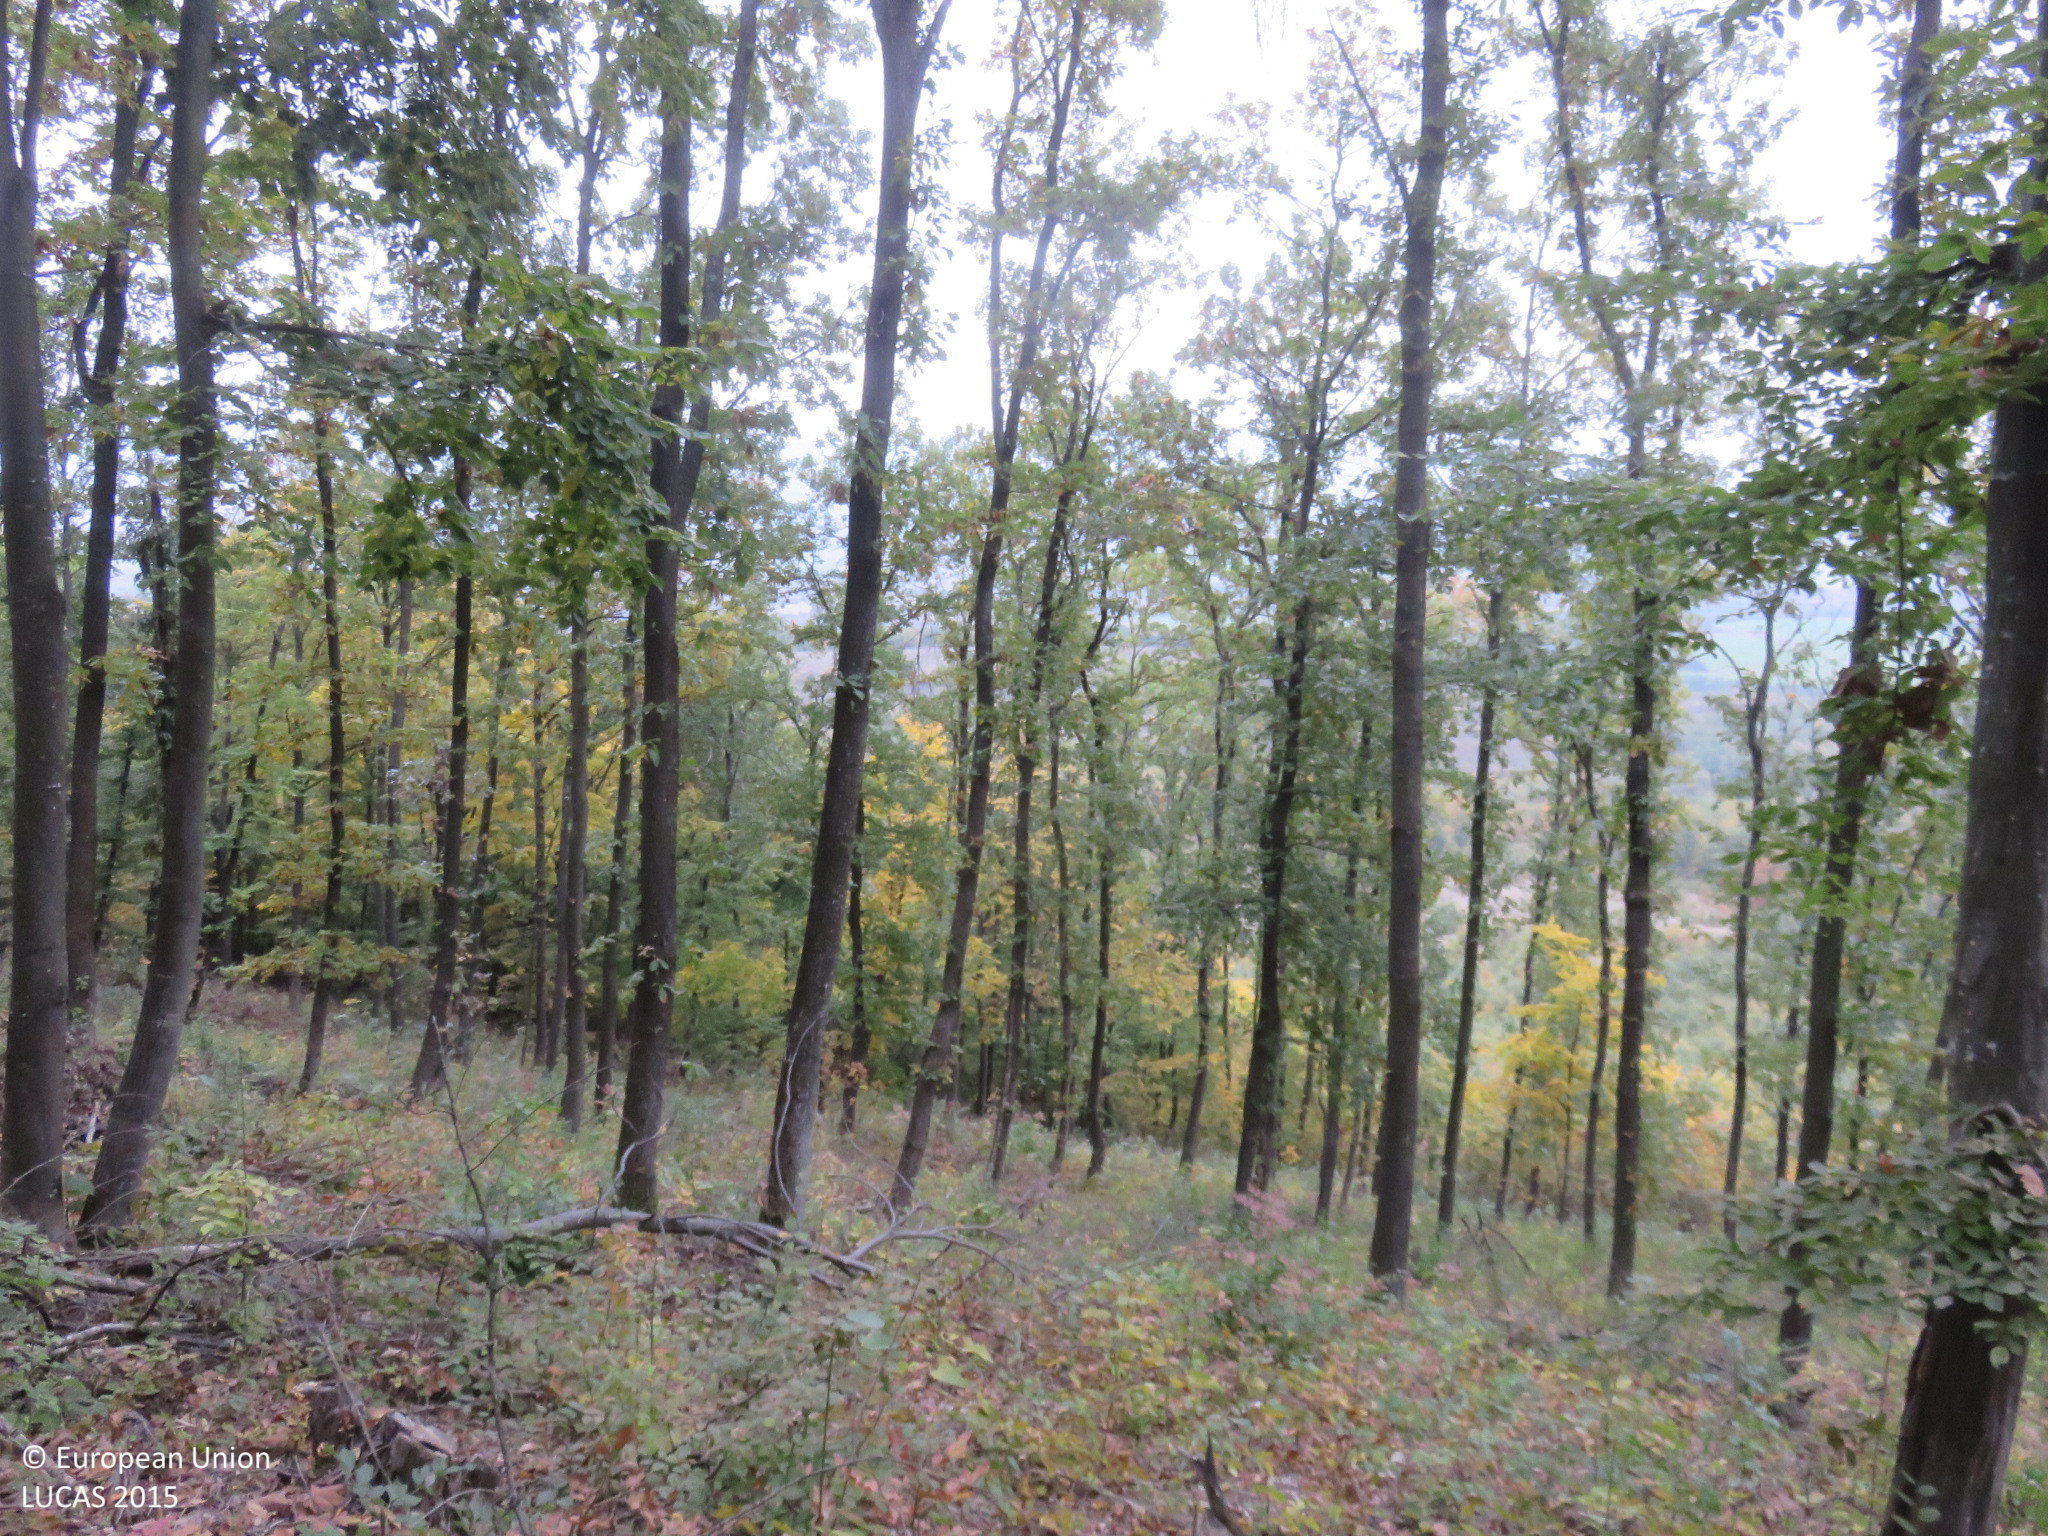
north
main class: Woodland
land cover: Broadleaved woodland
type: mesophytic deciduous forest
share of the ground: > 75 %
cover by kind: broadleaved forest trees 80 %, shrubs 10 %, herbaceous plants 10 %
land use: Forestry
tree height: > 5 m
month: October
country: BG
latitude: 42.9443
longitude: 24.9800
